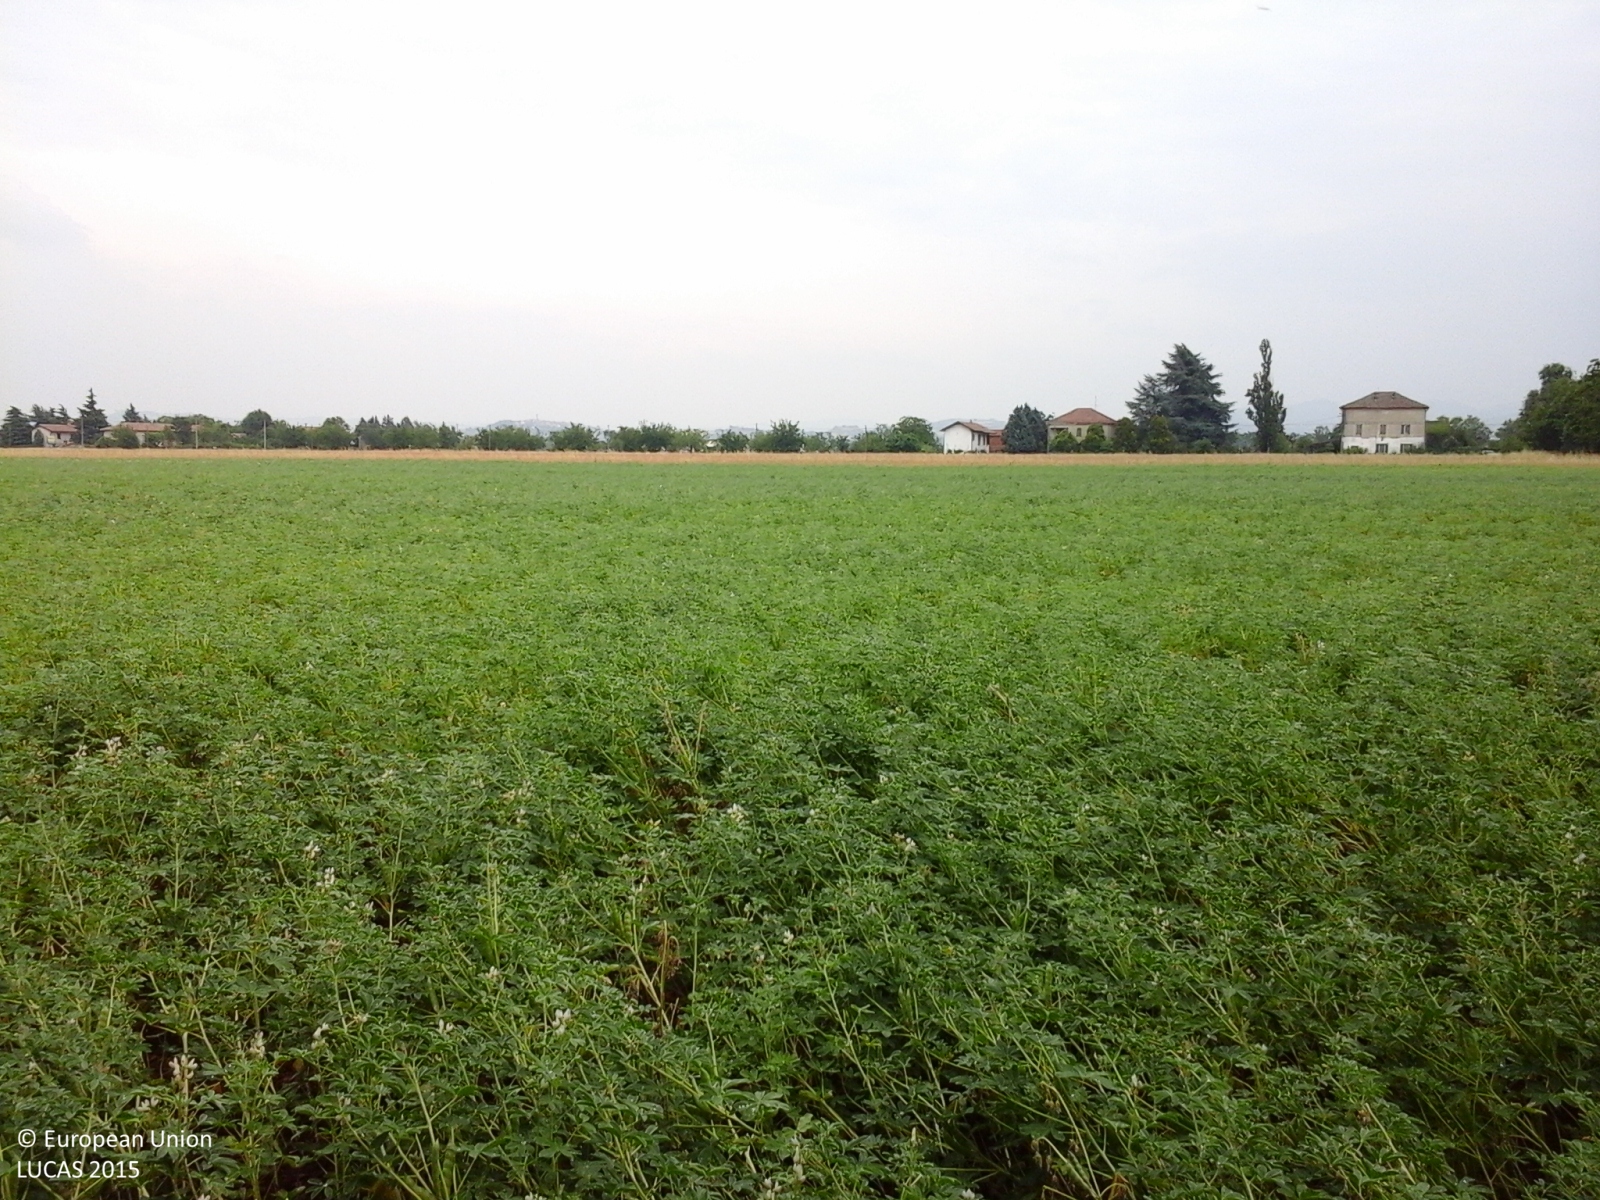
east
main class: Cropland
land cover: Dry pulses
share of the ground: > 75 %
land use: Agriculture (excluding fallow land and kitchen gardens)
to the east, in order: Dry pulses; Common wheat
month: June
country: IT
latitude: 44.8306
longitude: 8.8008
